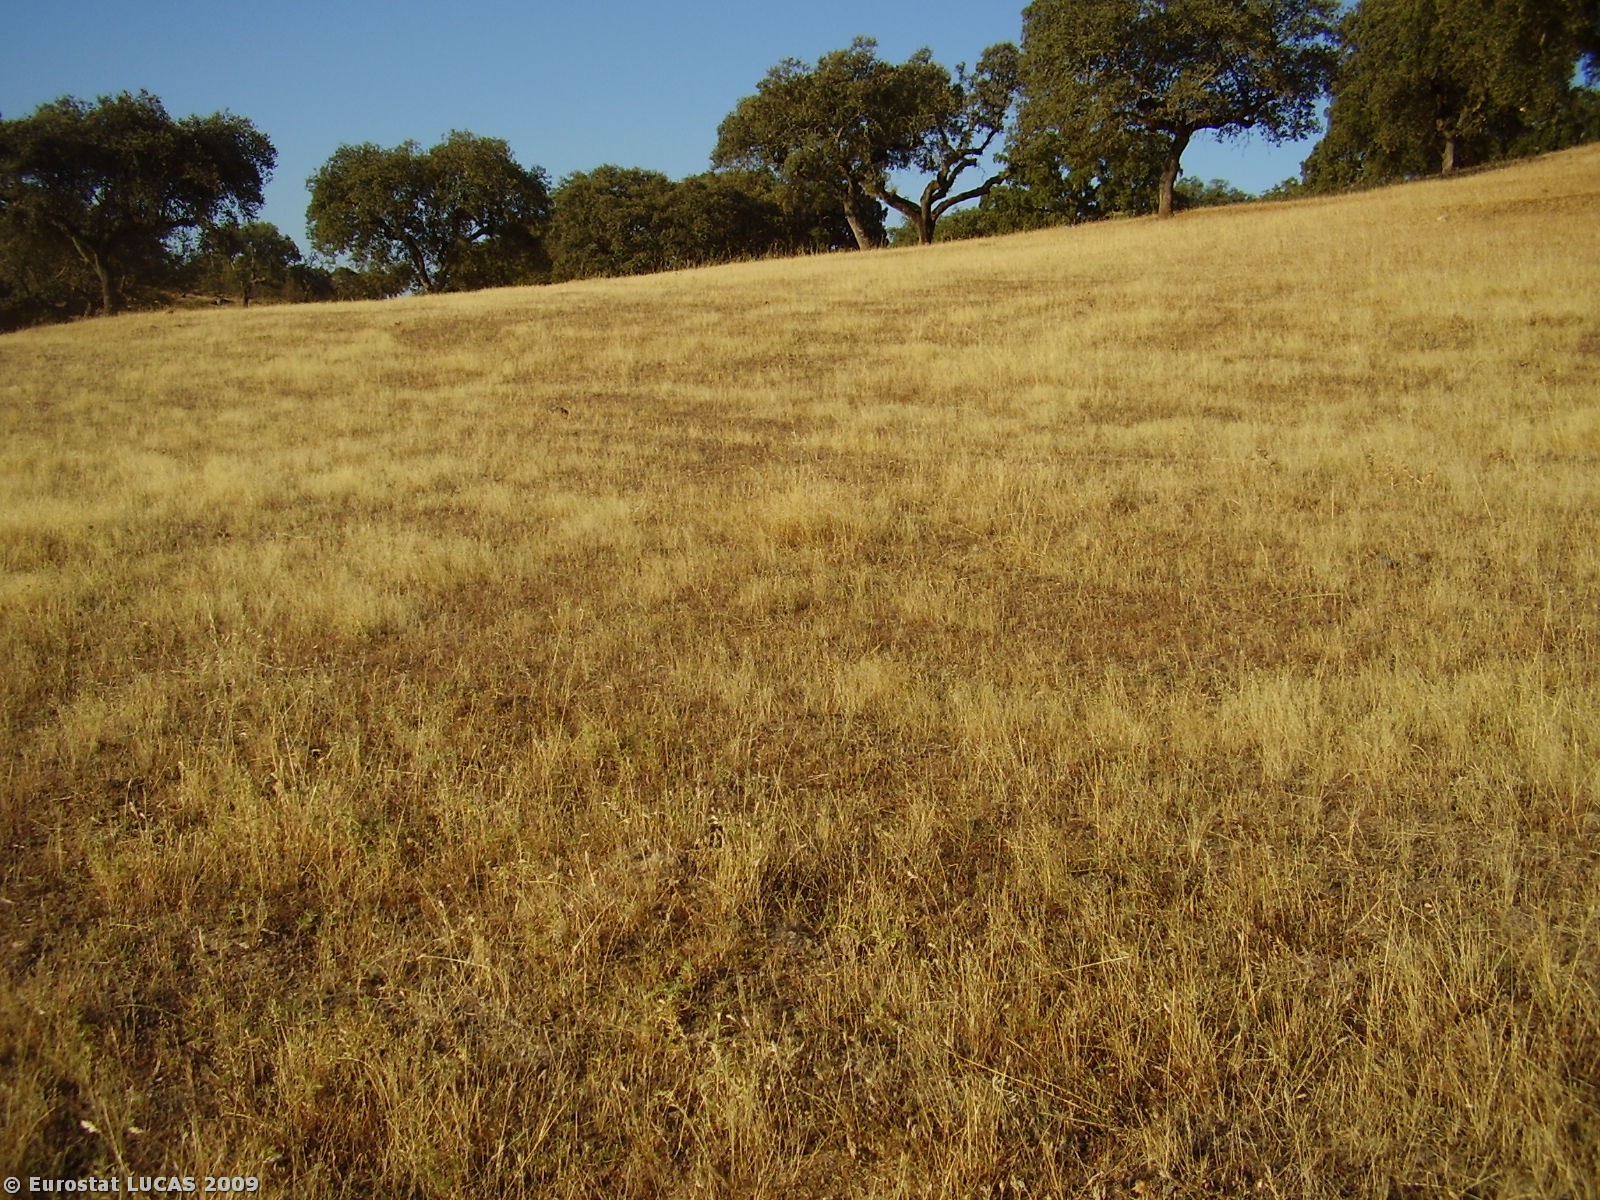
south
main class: Grassland
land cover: Grassland with sparse tree/shrub cover
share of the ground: > 75 %
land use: Agriculture (excluding fallow land and kitchen gardens)
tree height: > 5 m
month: July
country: PT
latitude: 38.6443
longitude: -7.2951
